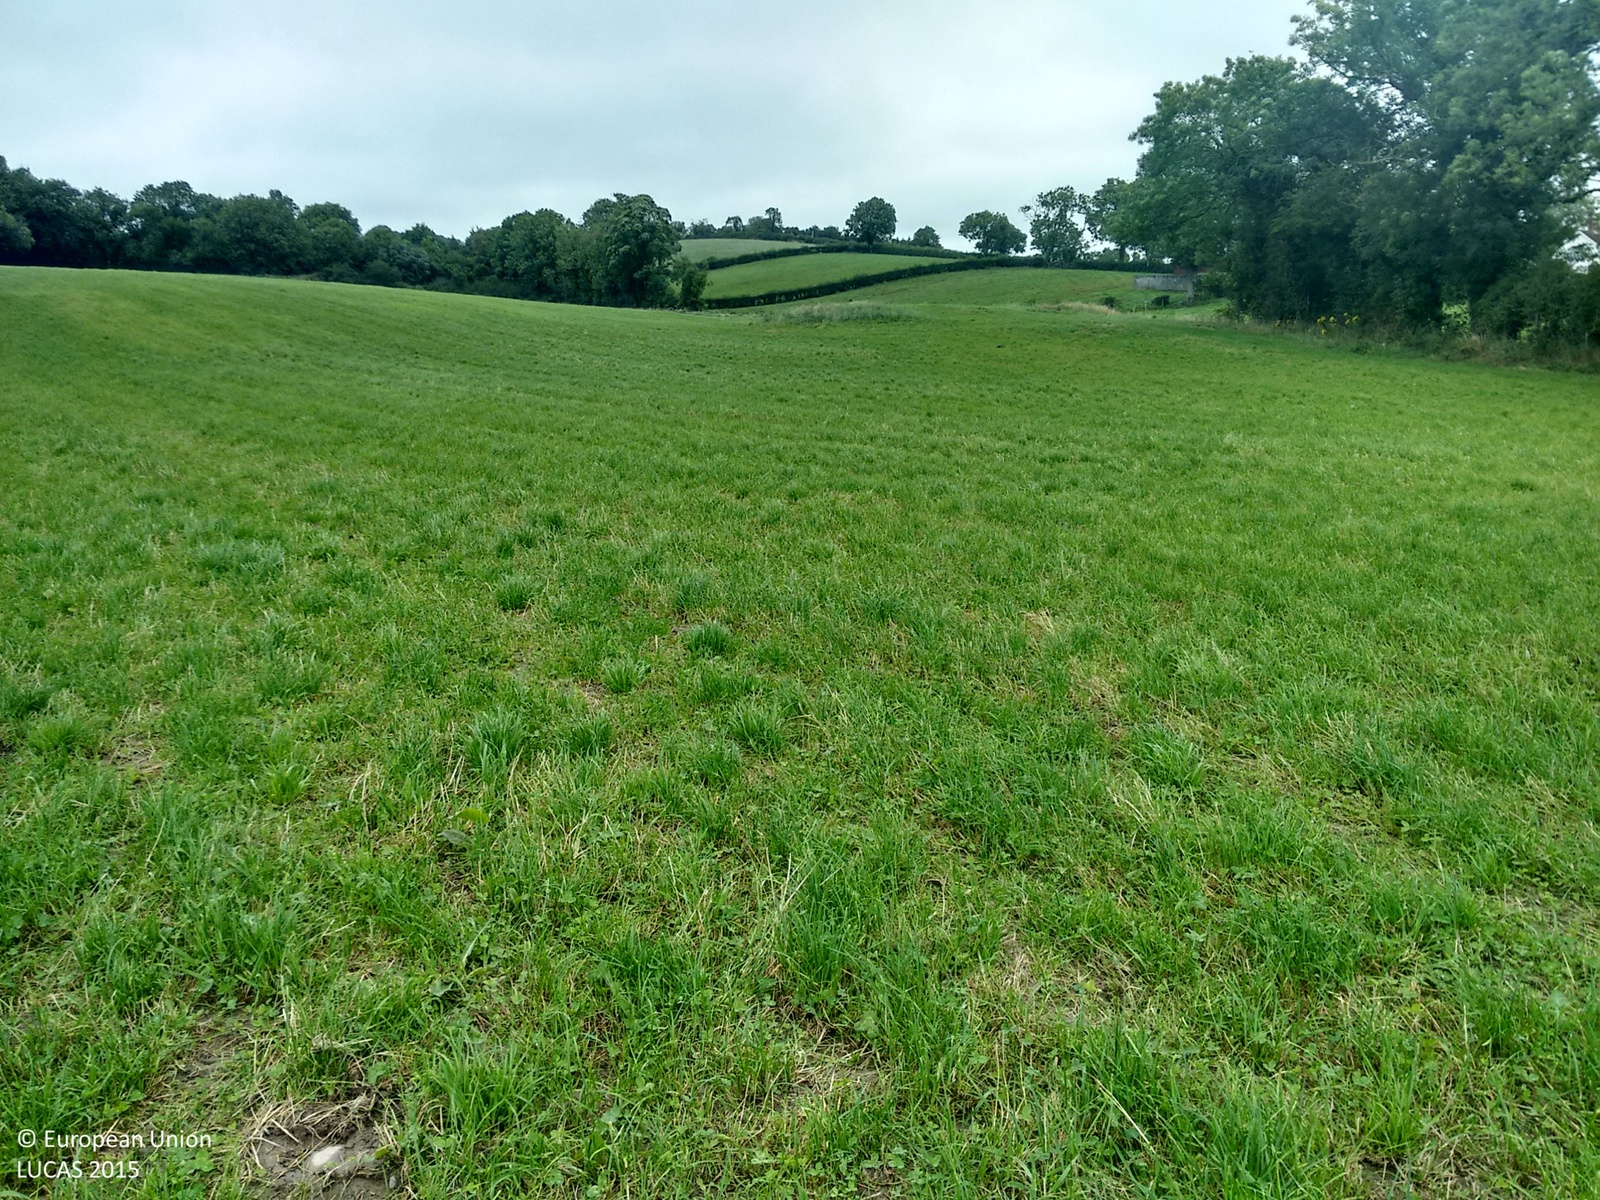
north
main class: Grassland
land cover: Grassland without tree/shrub cover
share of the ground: > 75 %
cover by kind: herbaceous plants 100 %
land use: Agriculture (excluding fallow land and kitchen gardens)
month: August
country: GB
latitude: 54.3571
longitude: -5.7845
